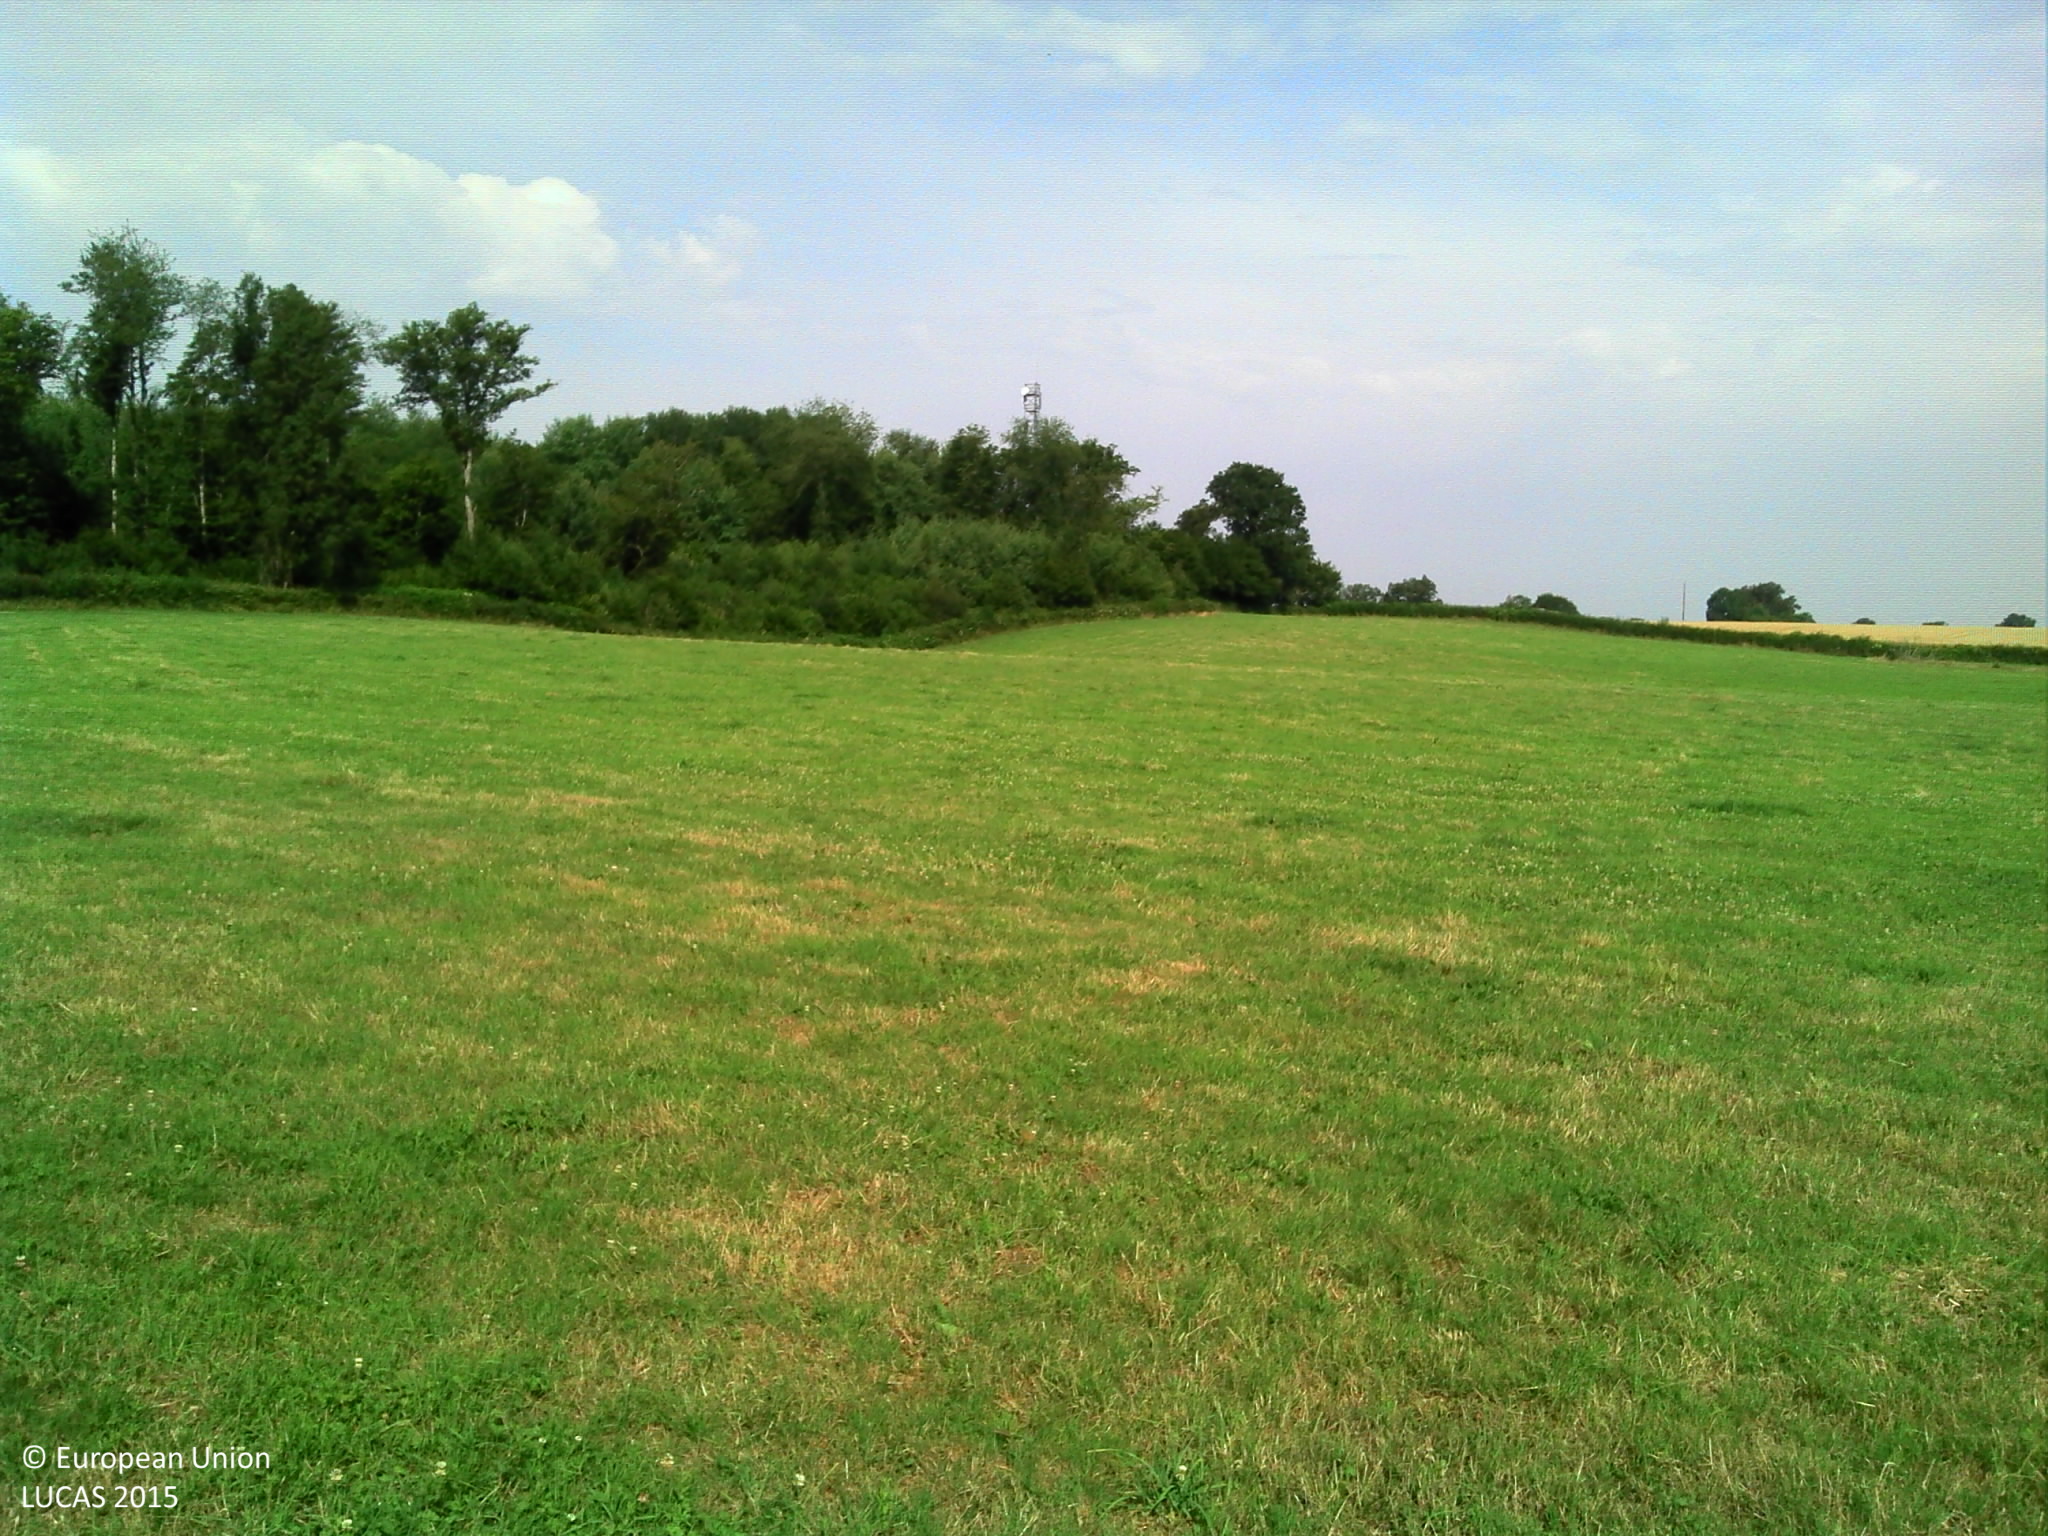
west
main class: Grassland
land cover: Grassland without tree/shrub cover
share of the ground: > 75 %
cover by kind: herbaceous plants 100 %
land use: Agriculture (excluding fallow land and kitchen gardens)
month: July
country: FR
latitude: 47.1350
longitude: 3.6031
